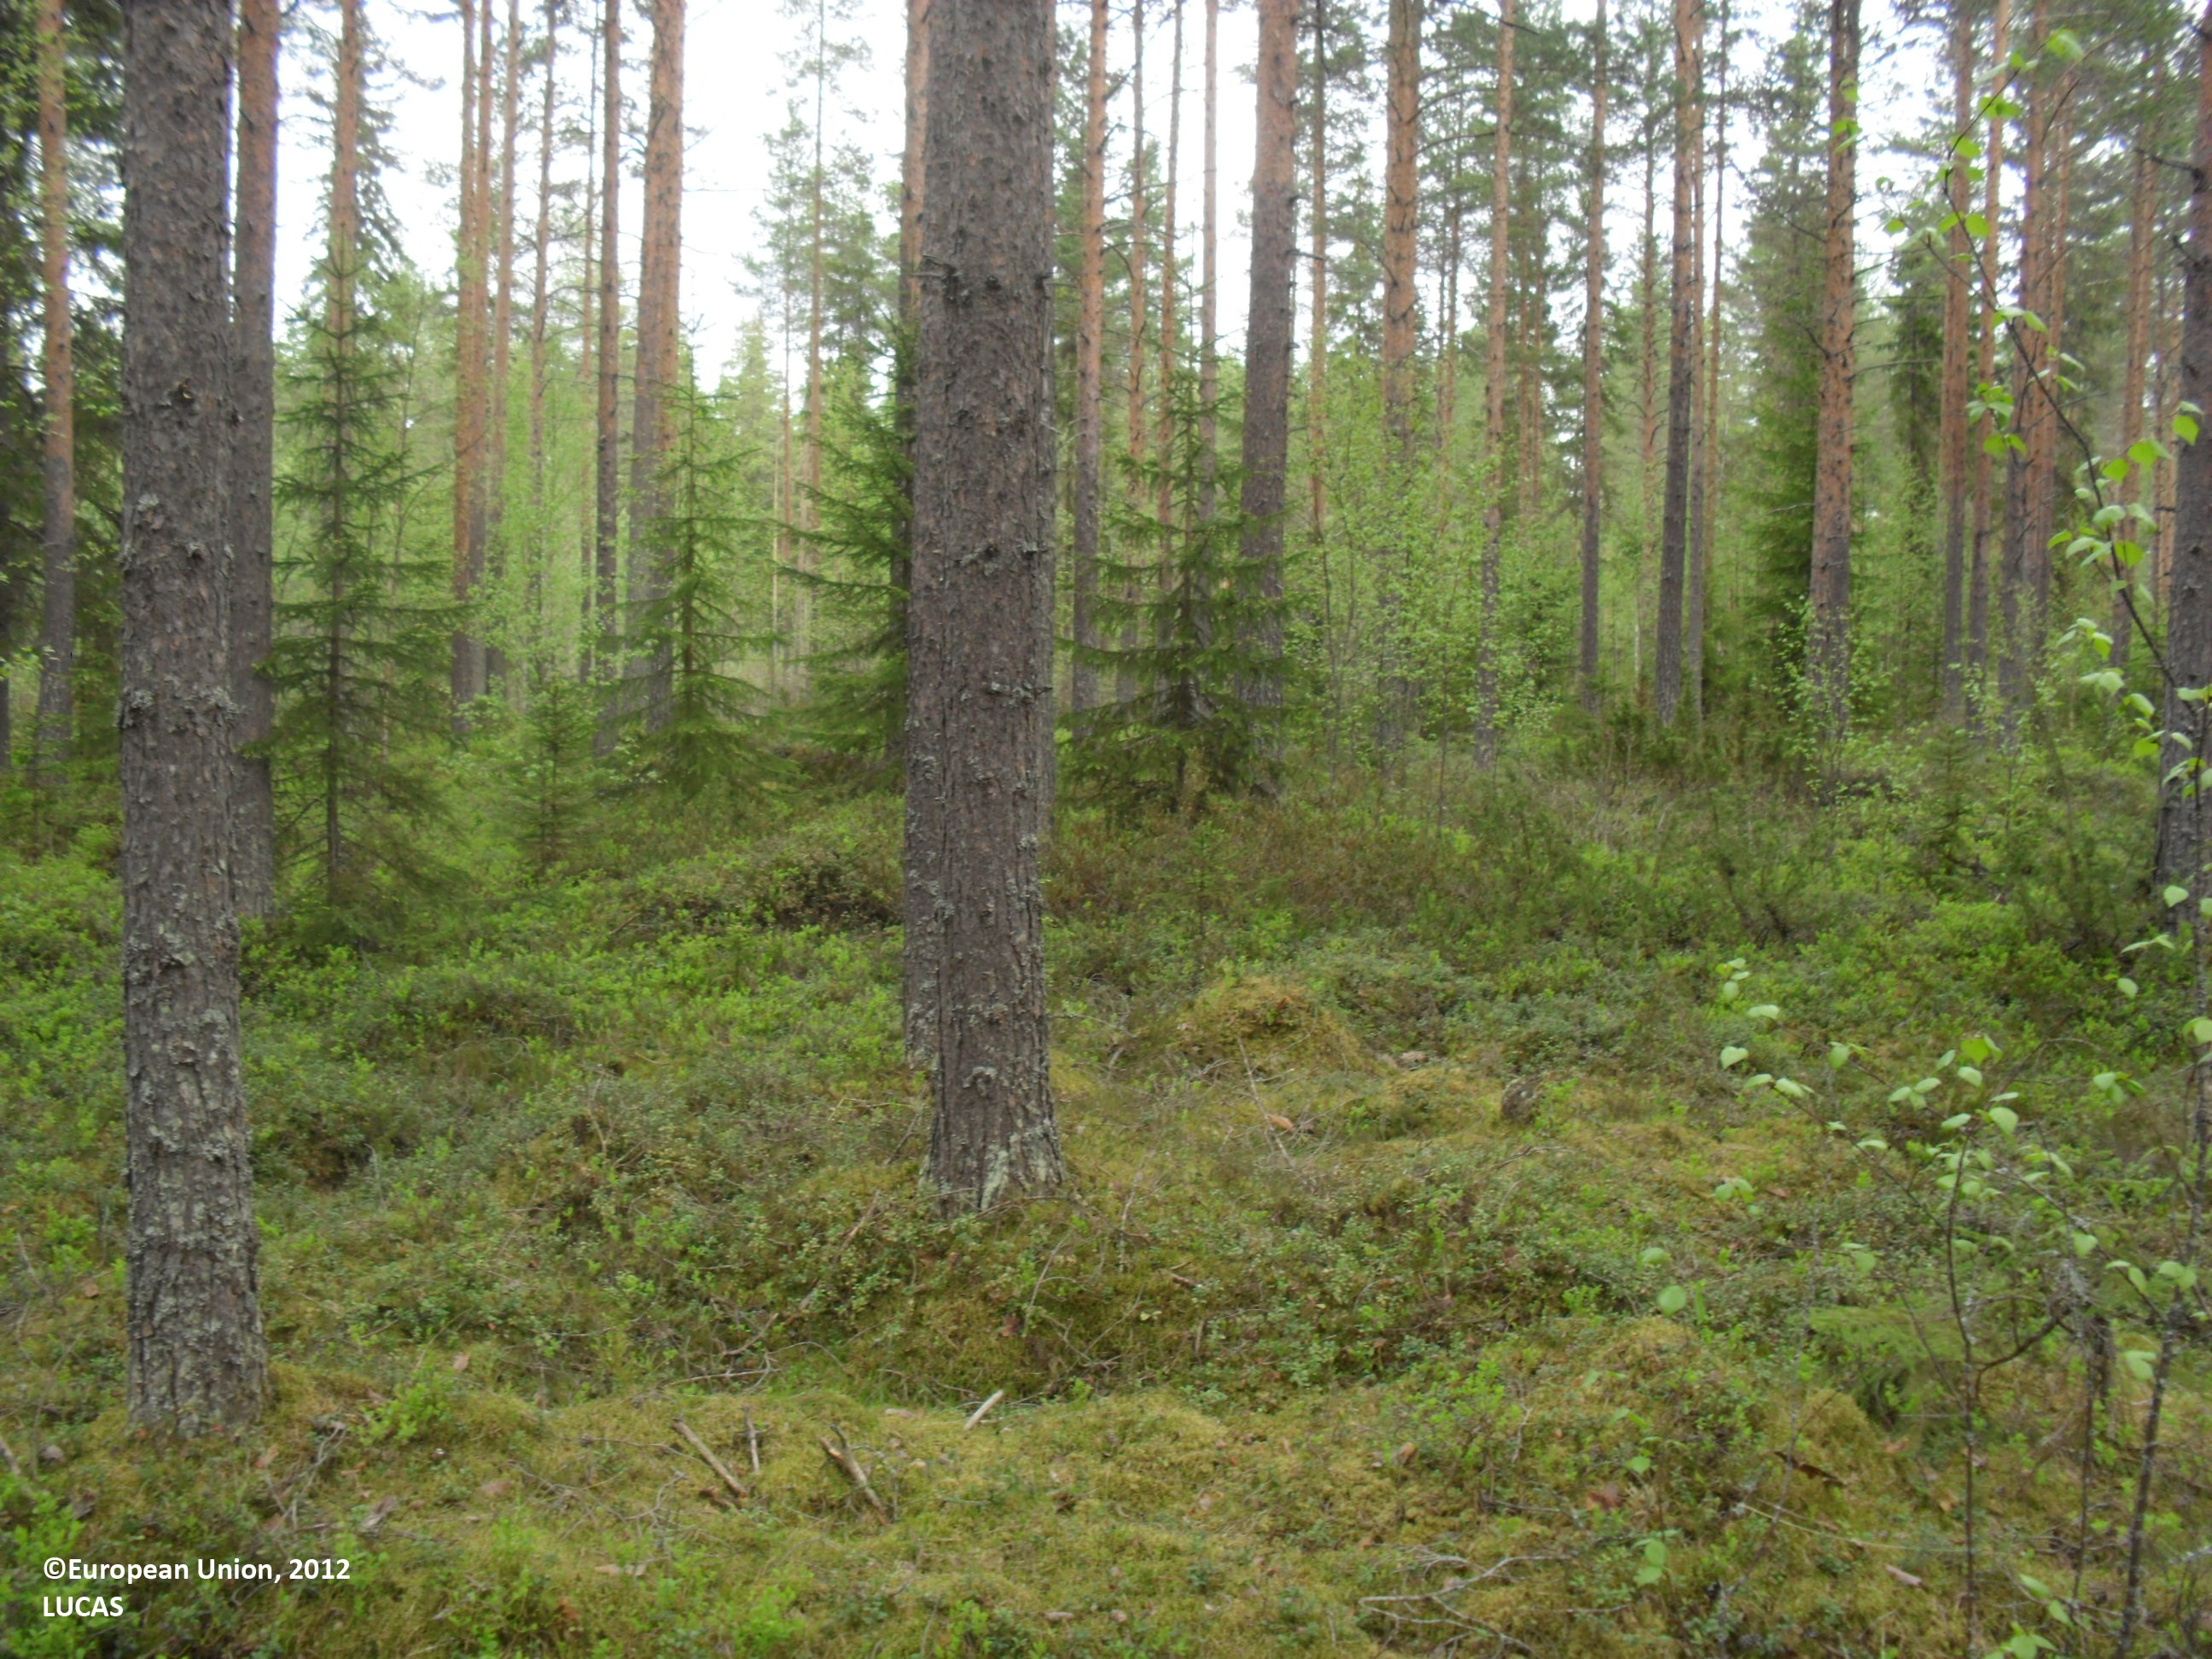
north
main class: Woodland
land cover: Pine dominated coniferous woodland
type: boreal forest
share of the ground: 50 - 75 %
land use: Forestry
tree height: > 5 m
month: June
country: FI
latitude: 63.0996
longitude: 23.3164
